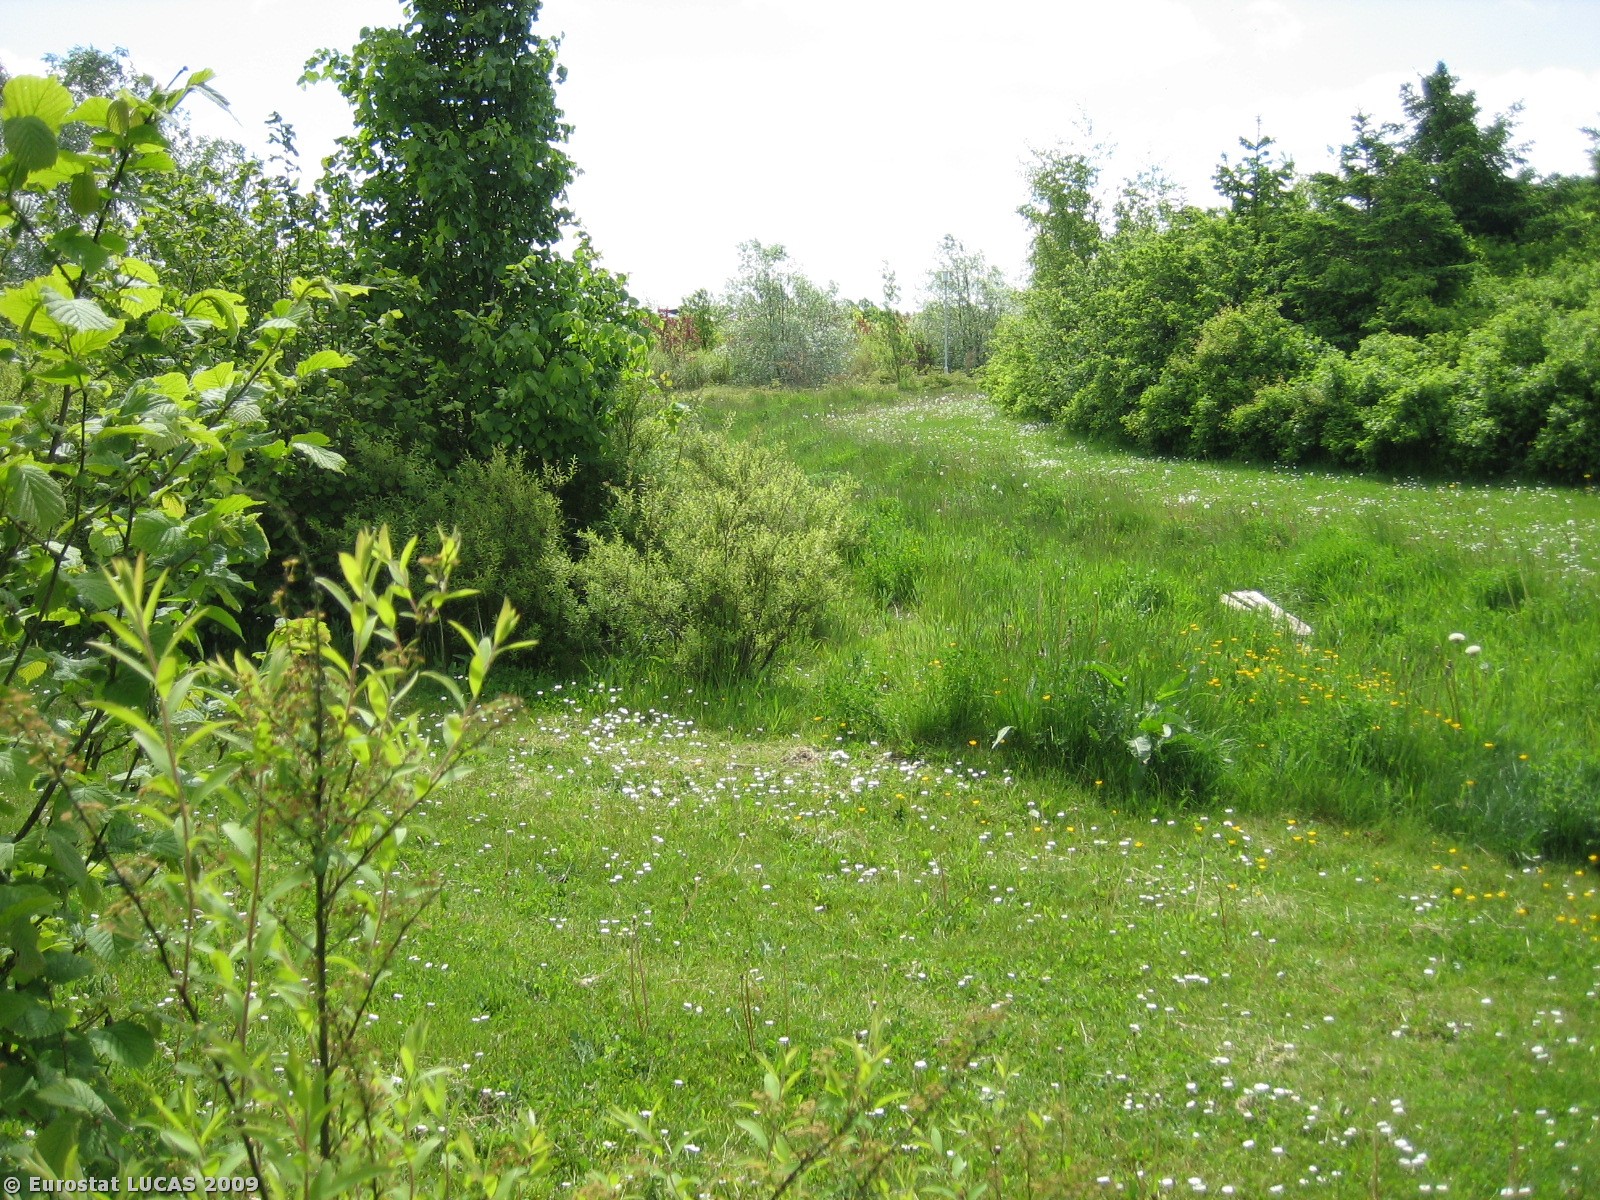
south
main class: Shrubland
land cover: Shrubland with sparse tree cover
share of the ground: > 75 %
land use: Amenities, museums, leisure
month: May
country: DK
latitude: 56.1118
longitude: 8.9880
